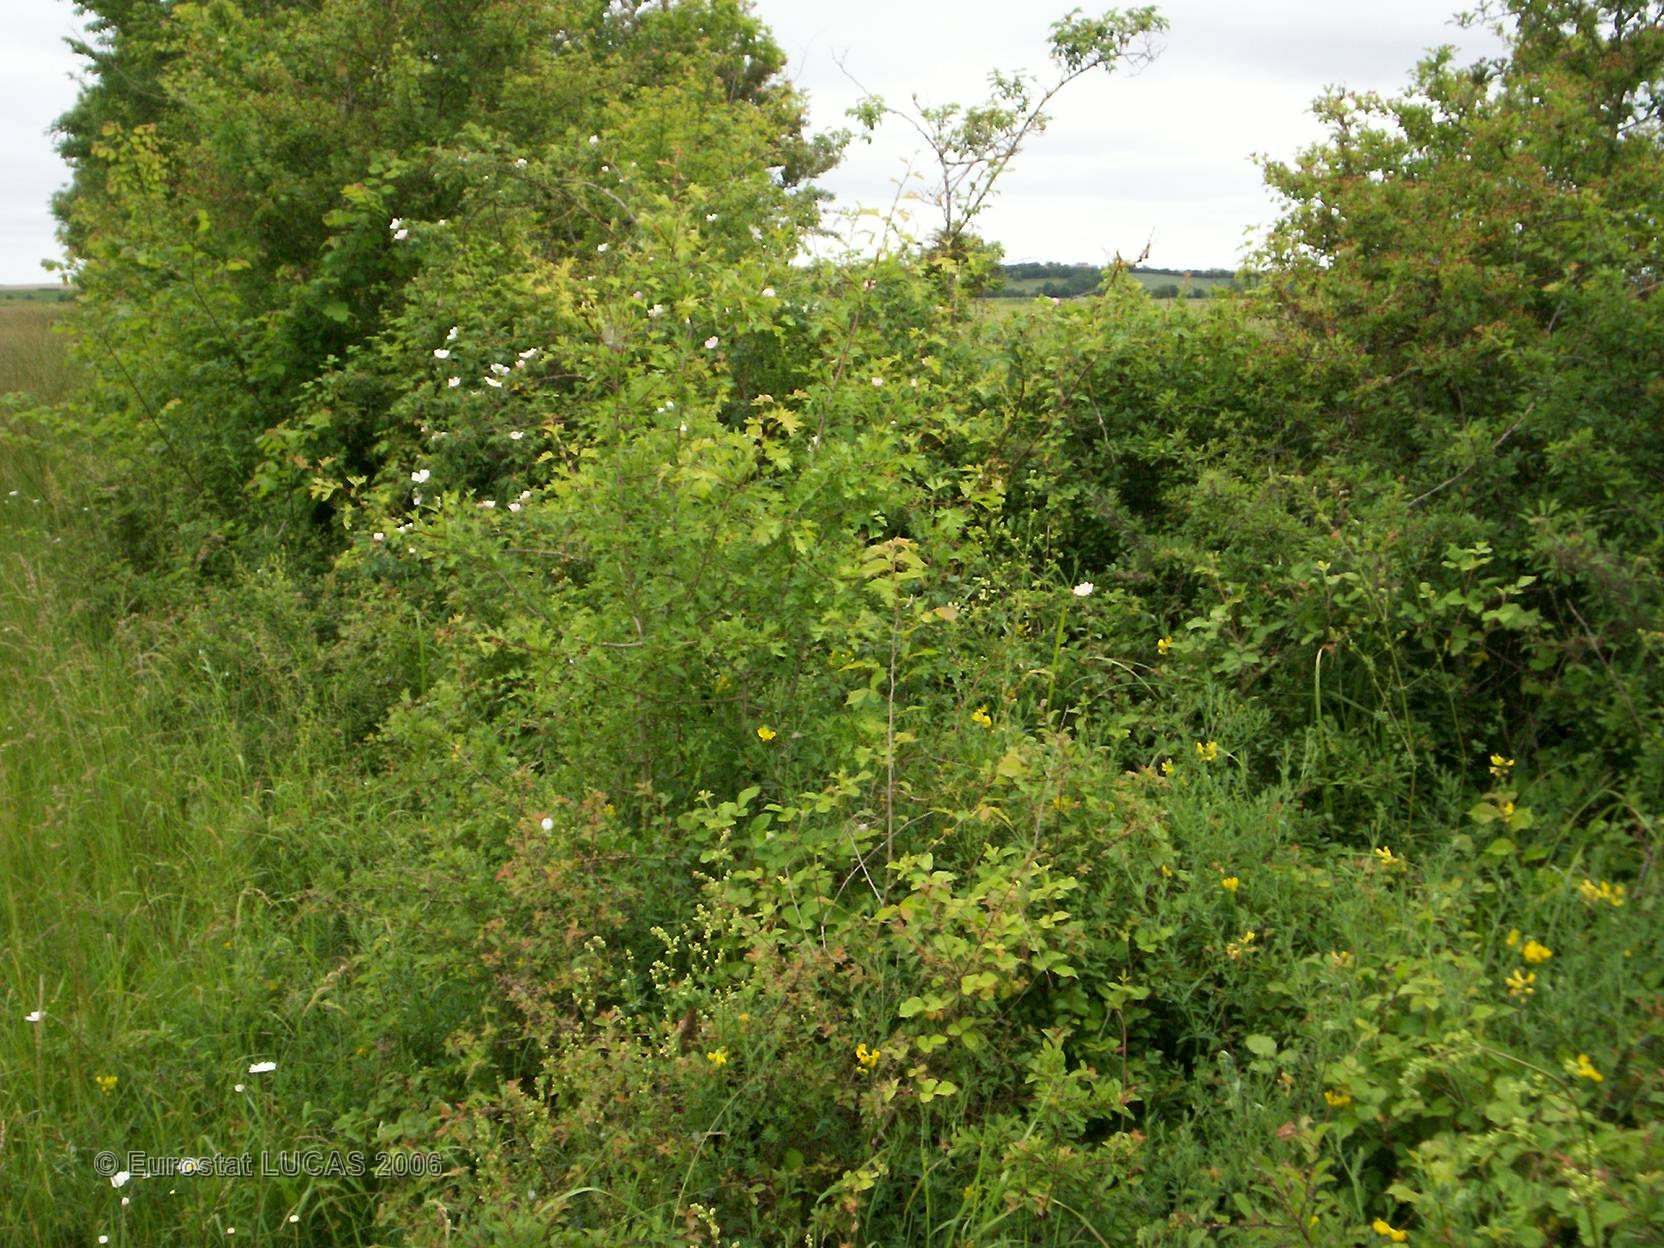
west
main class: Grassland
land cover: Grassland without tree/shrub cover
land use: Agriculture (excluding fallow land and kitchen gardens)
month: May
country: FR
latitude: 46.0293
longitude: -0.8934
